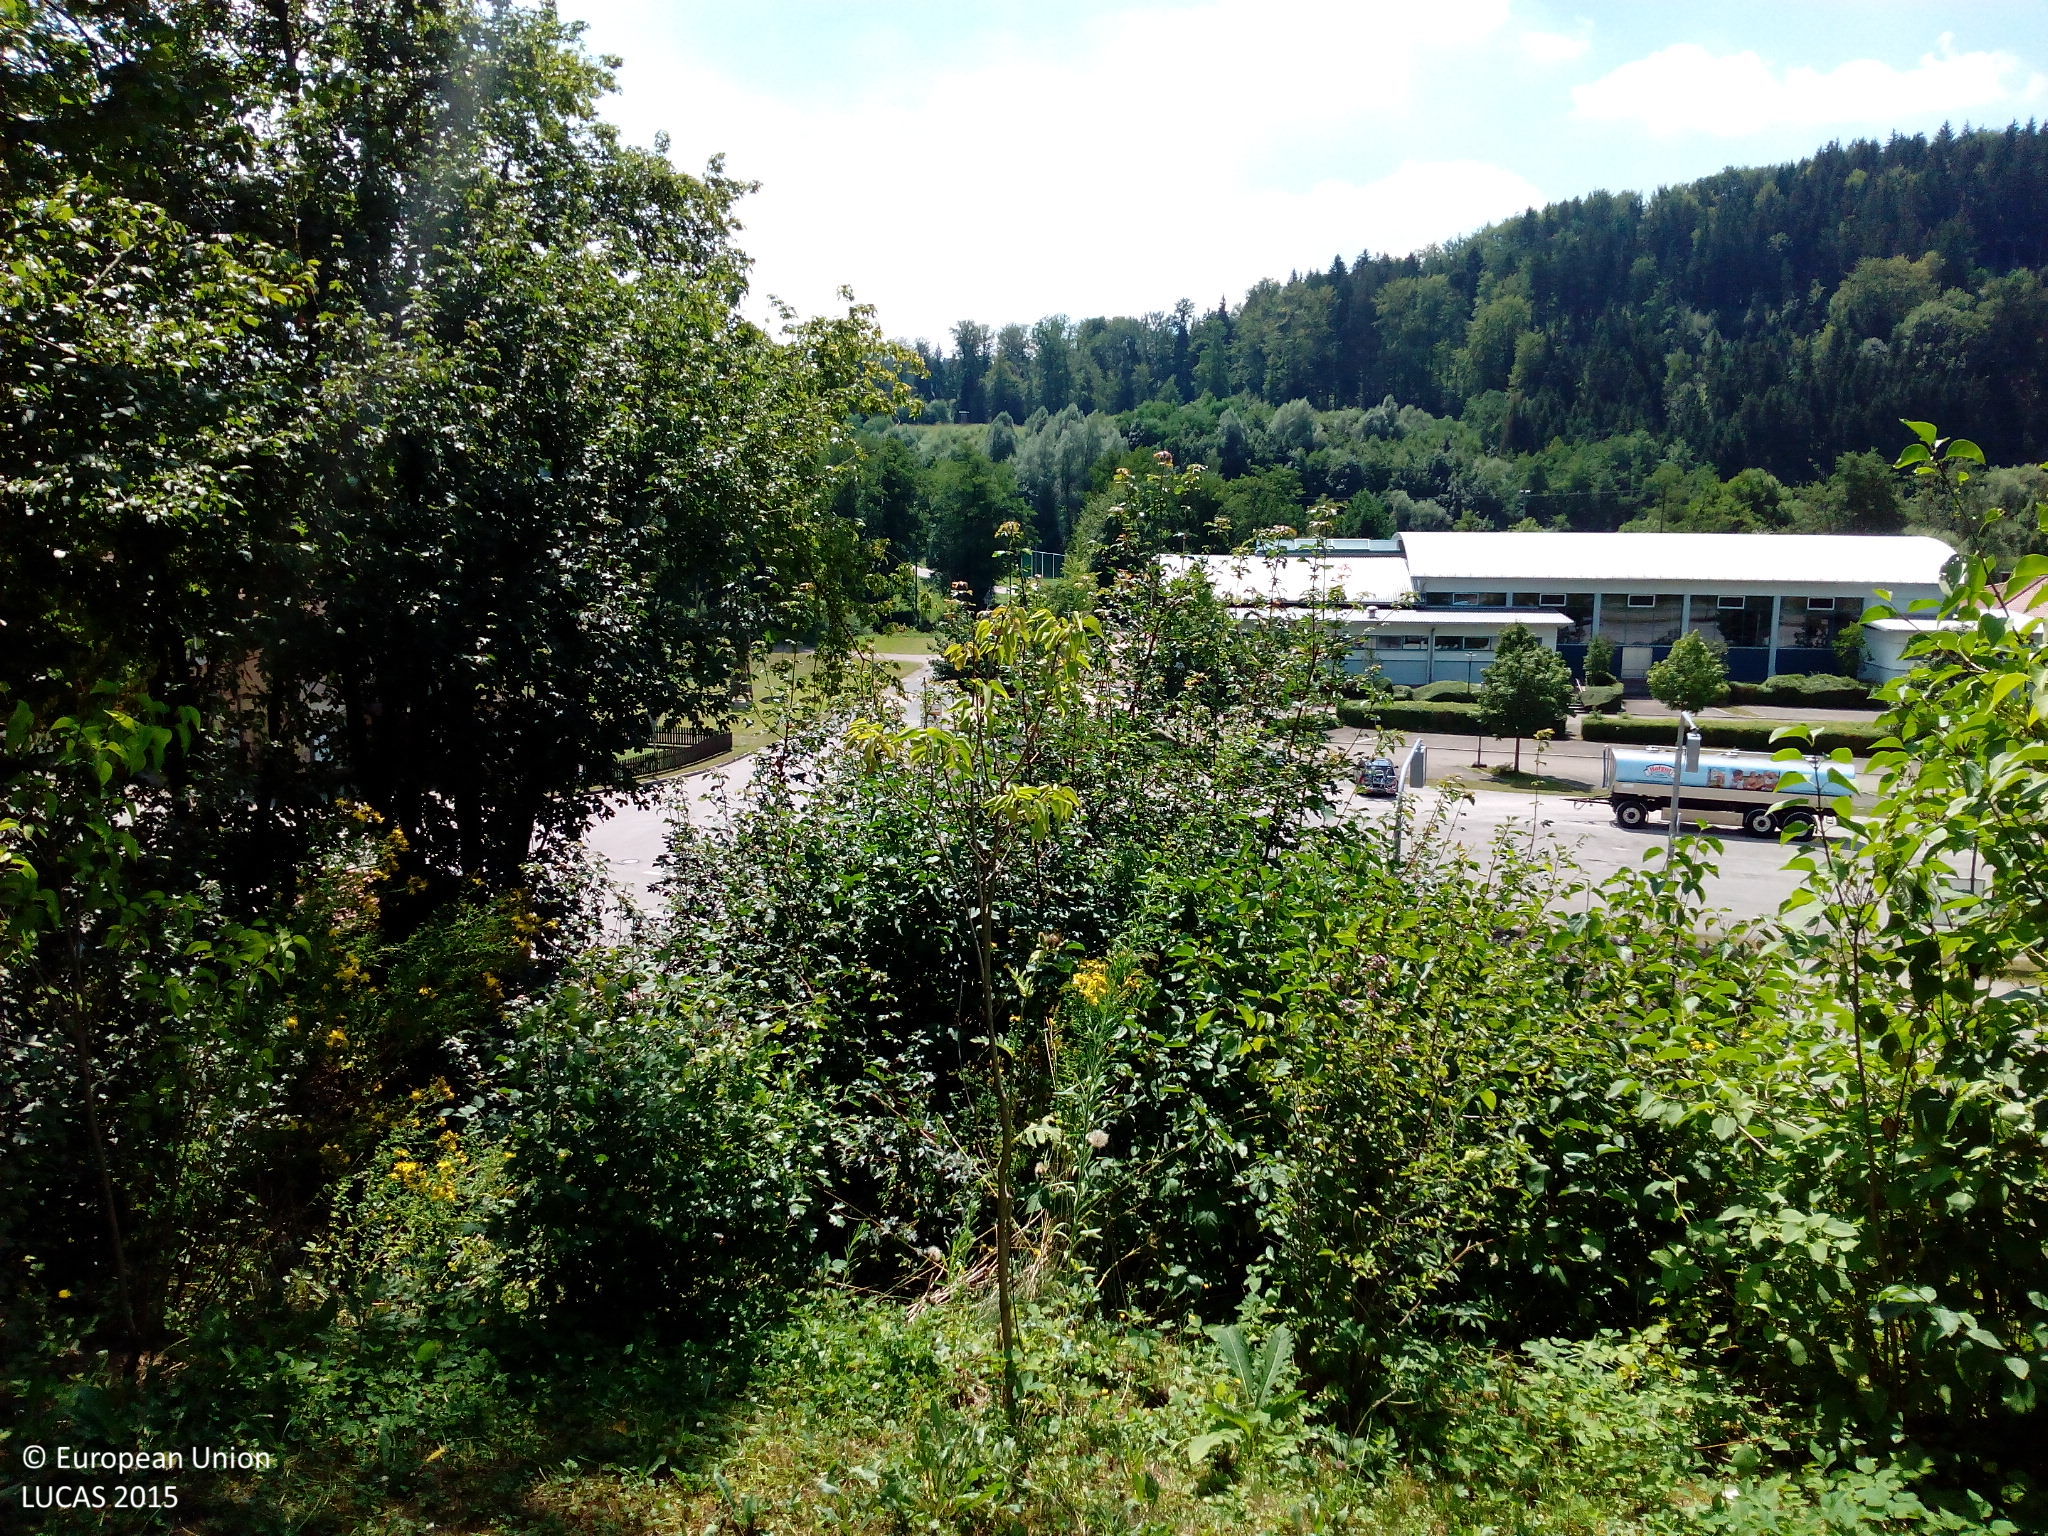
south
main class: Grassland
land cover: Grassland without tree/shrub cover
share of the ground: > 75 %
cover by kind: herbaceous plants 100 %
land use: Residential
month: July
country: DE
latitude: 48.9611
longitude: 9.8498
